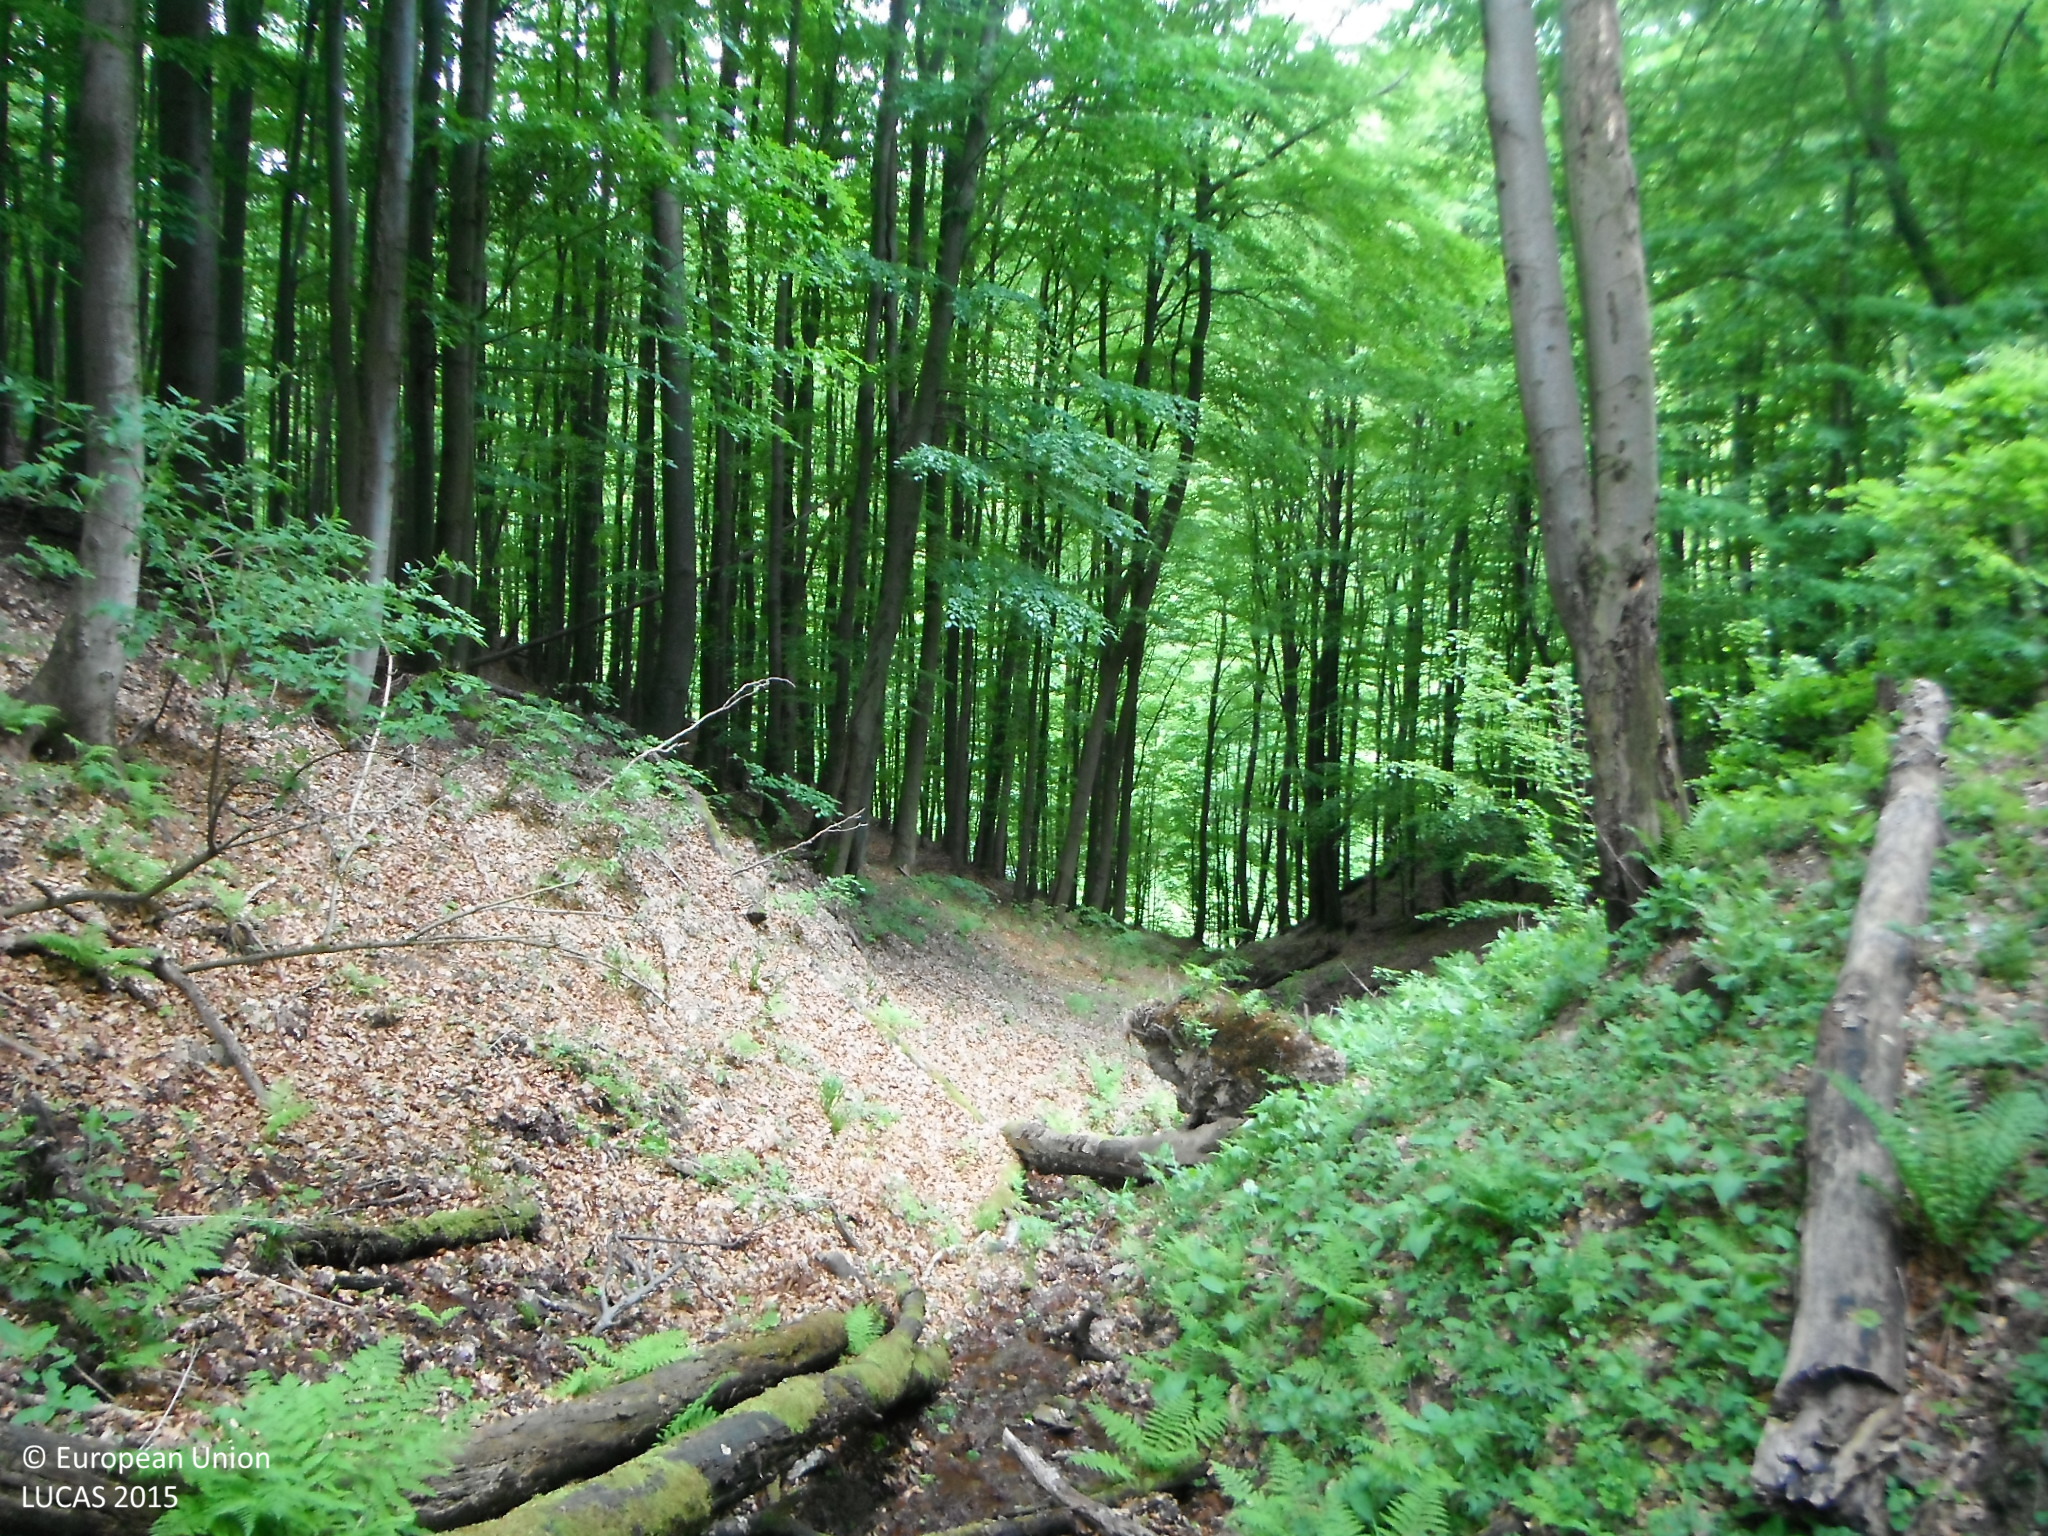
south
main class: Woodland
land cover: Broadleaved woodland
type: beech forest
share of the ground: > 75 %
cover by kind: broadleaved forest trees 50 %, shrubs 20 %, unconsolidated bare surface 20 %, herbaceous plants 10 %
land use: Forestry
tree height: > 5 m
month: May
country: SK
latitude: 48.3492
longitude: 17.2010
